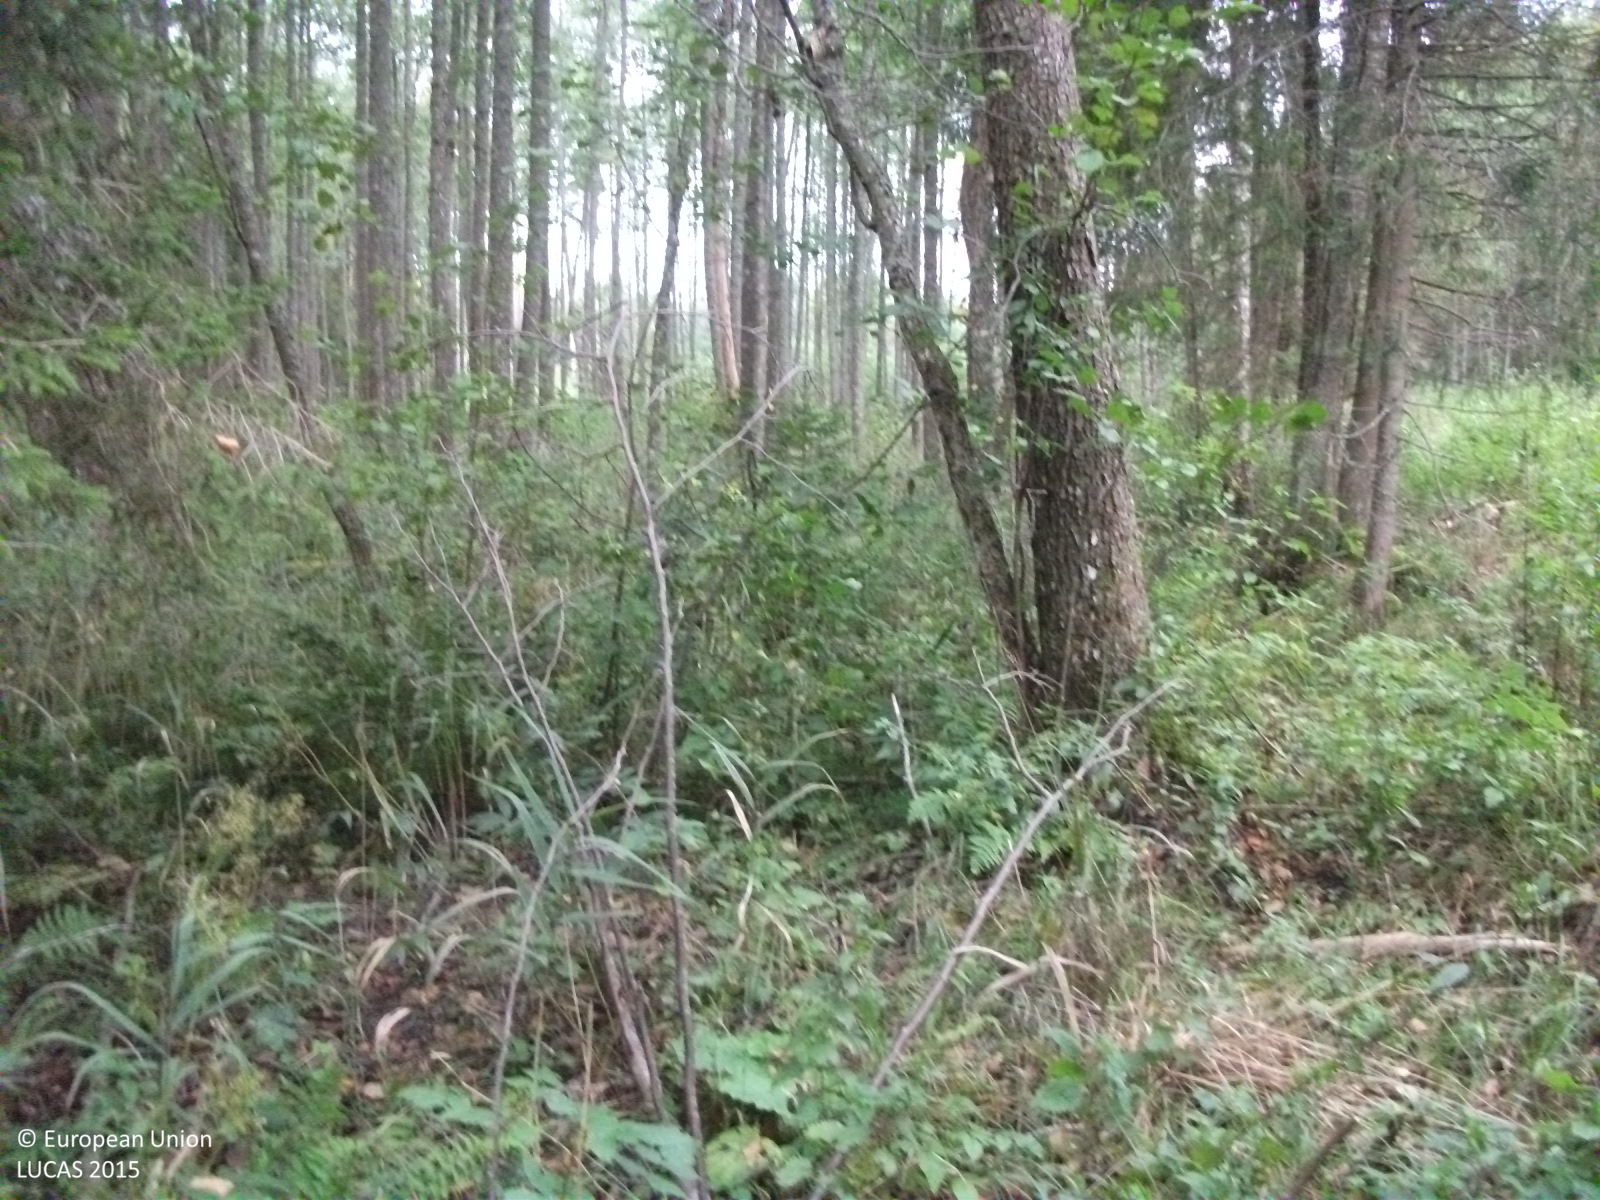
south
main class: Woodland
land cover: Broadleaved woodland
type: non-riverine alder, birch or aspen forest
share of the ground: > 75 %
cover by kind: broadleaved forest trees 90 %, shrubs 5 %, herbaceous plants 5 %
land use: Forestry
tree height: > 5 m
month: September
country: LV
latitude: 57.7505
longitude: 24.5579
